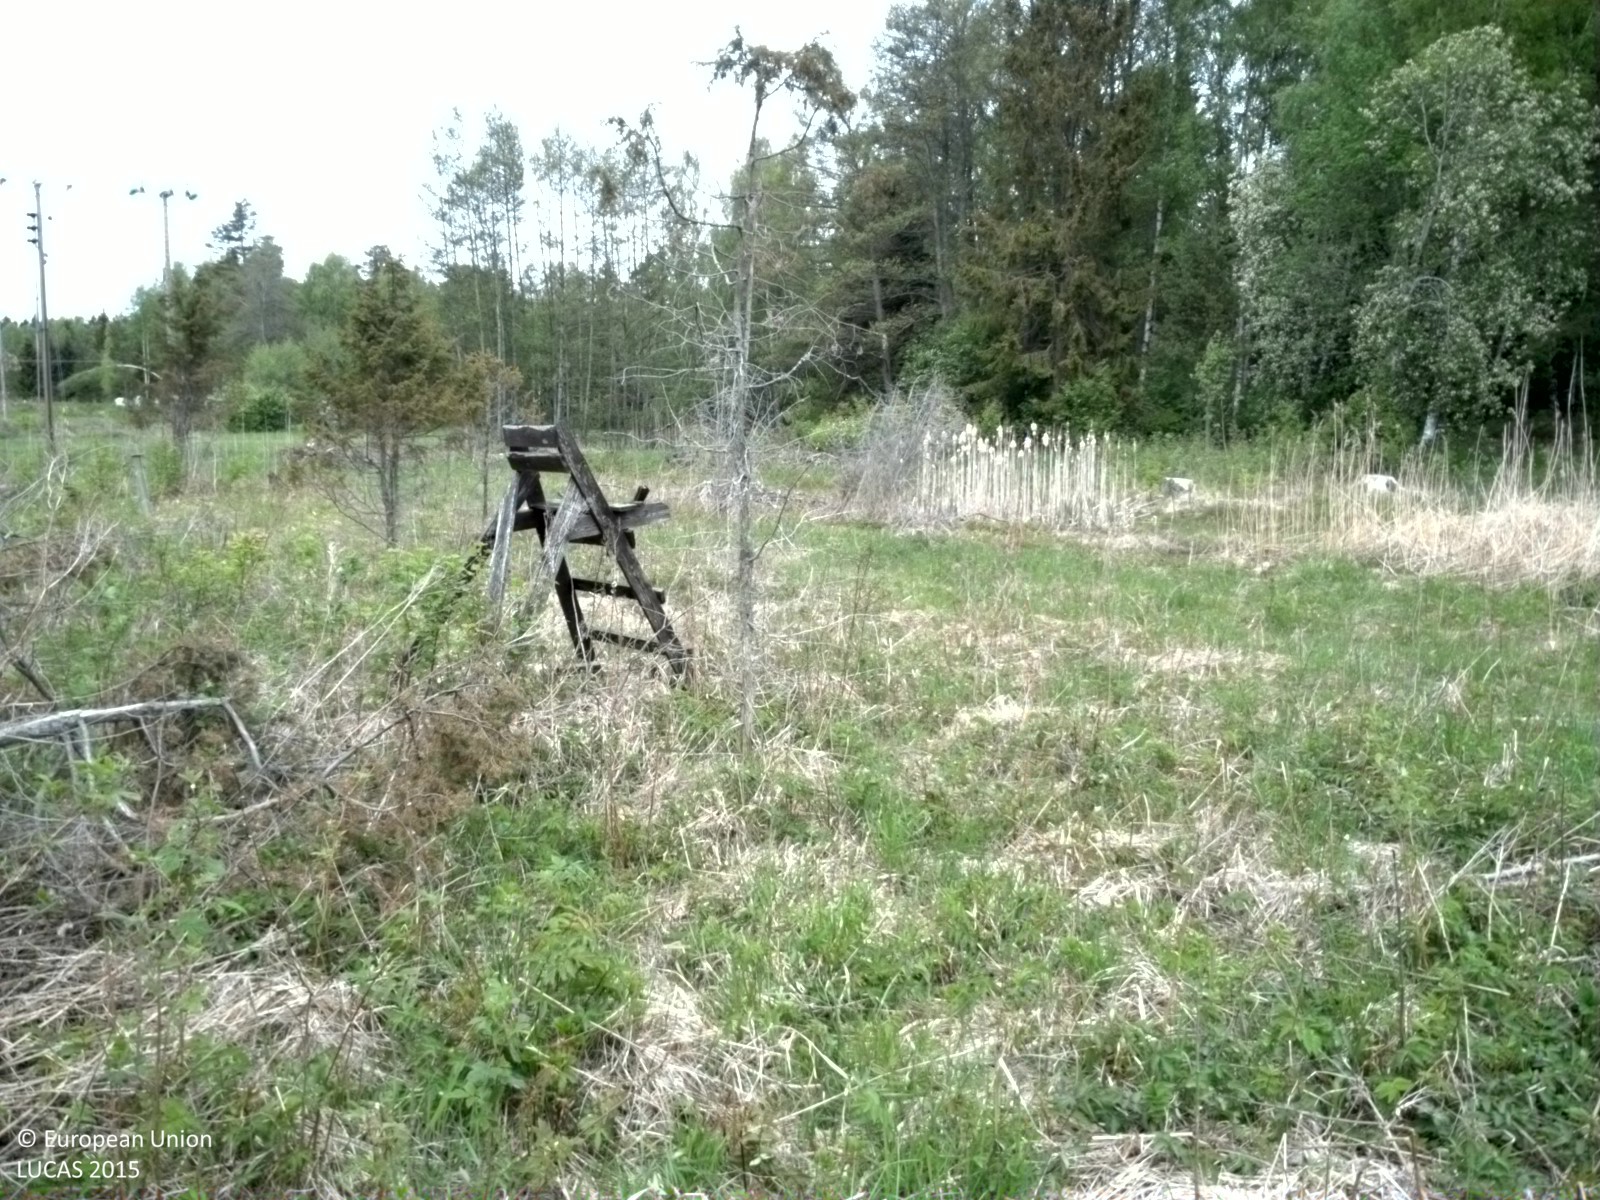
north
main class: Shrubland
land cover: Shrubland with sparse tree cover
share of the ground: 50 - 75 %
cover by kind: shrubs 65 %, herbaceous plants 30 %, broadleaved forest trees 5 %
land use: Forestry
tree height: < 5 m
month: May
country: SE
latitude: 60.3411
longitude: 18.4927
